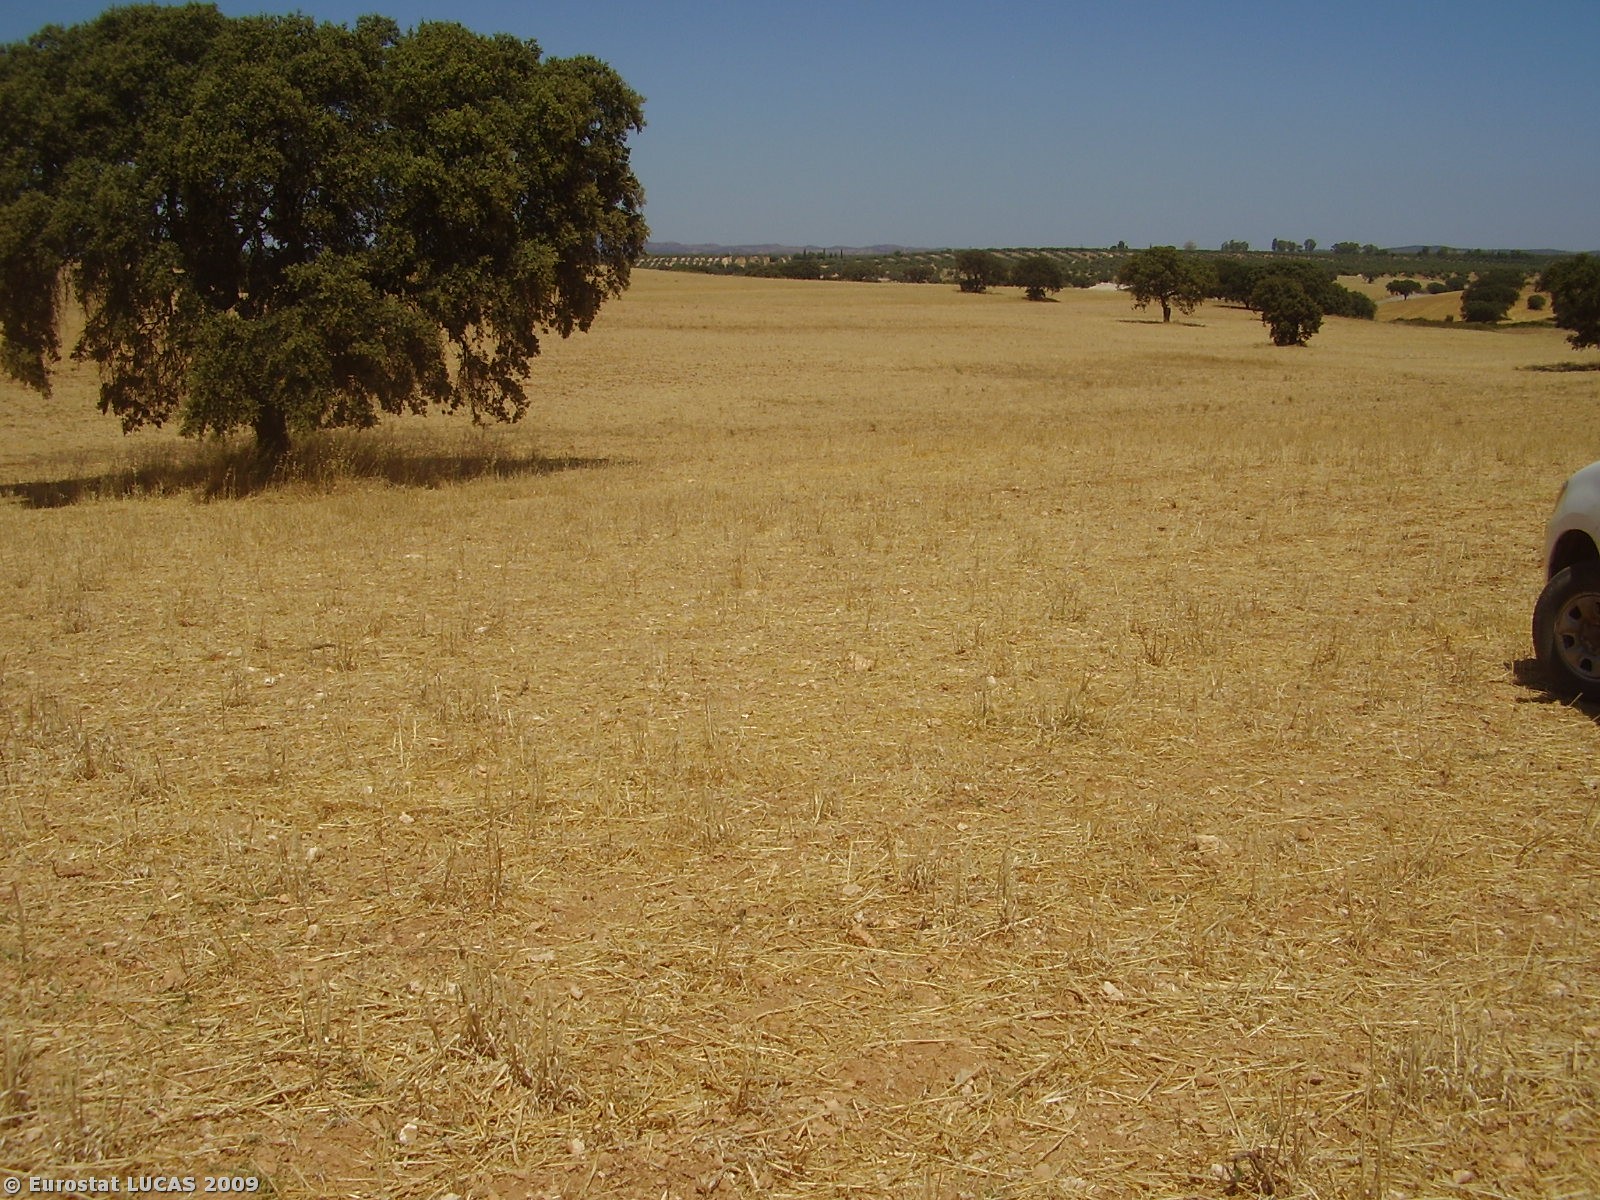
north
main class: Cropland
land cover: Oats
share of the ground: < 10 %
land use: Agriculture (excluding fallow land and kitchen gardens)
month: August
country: PT
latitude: 38.0947
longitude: -7.5712
